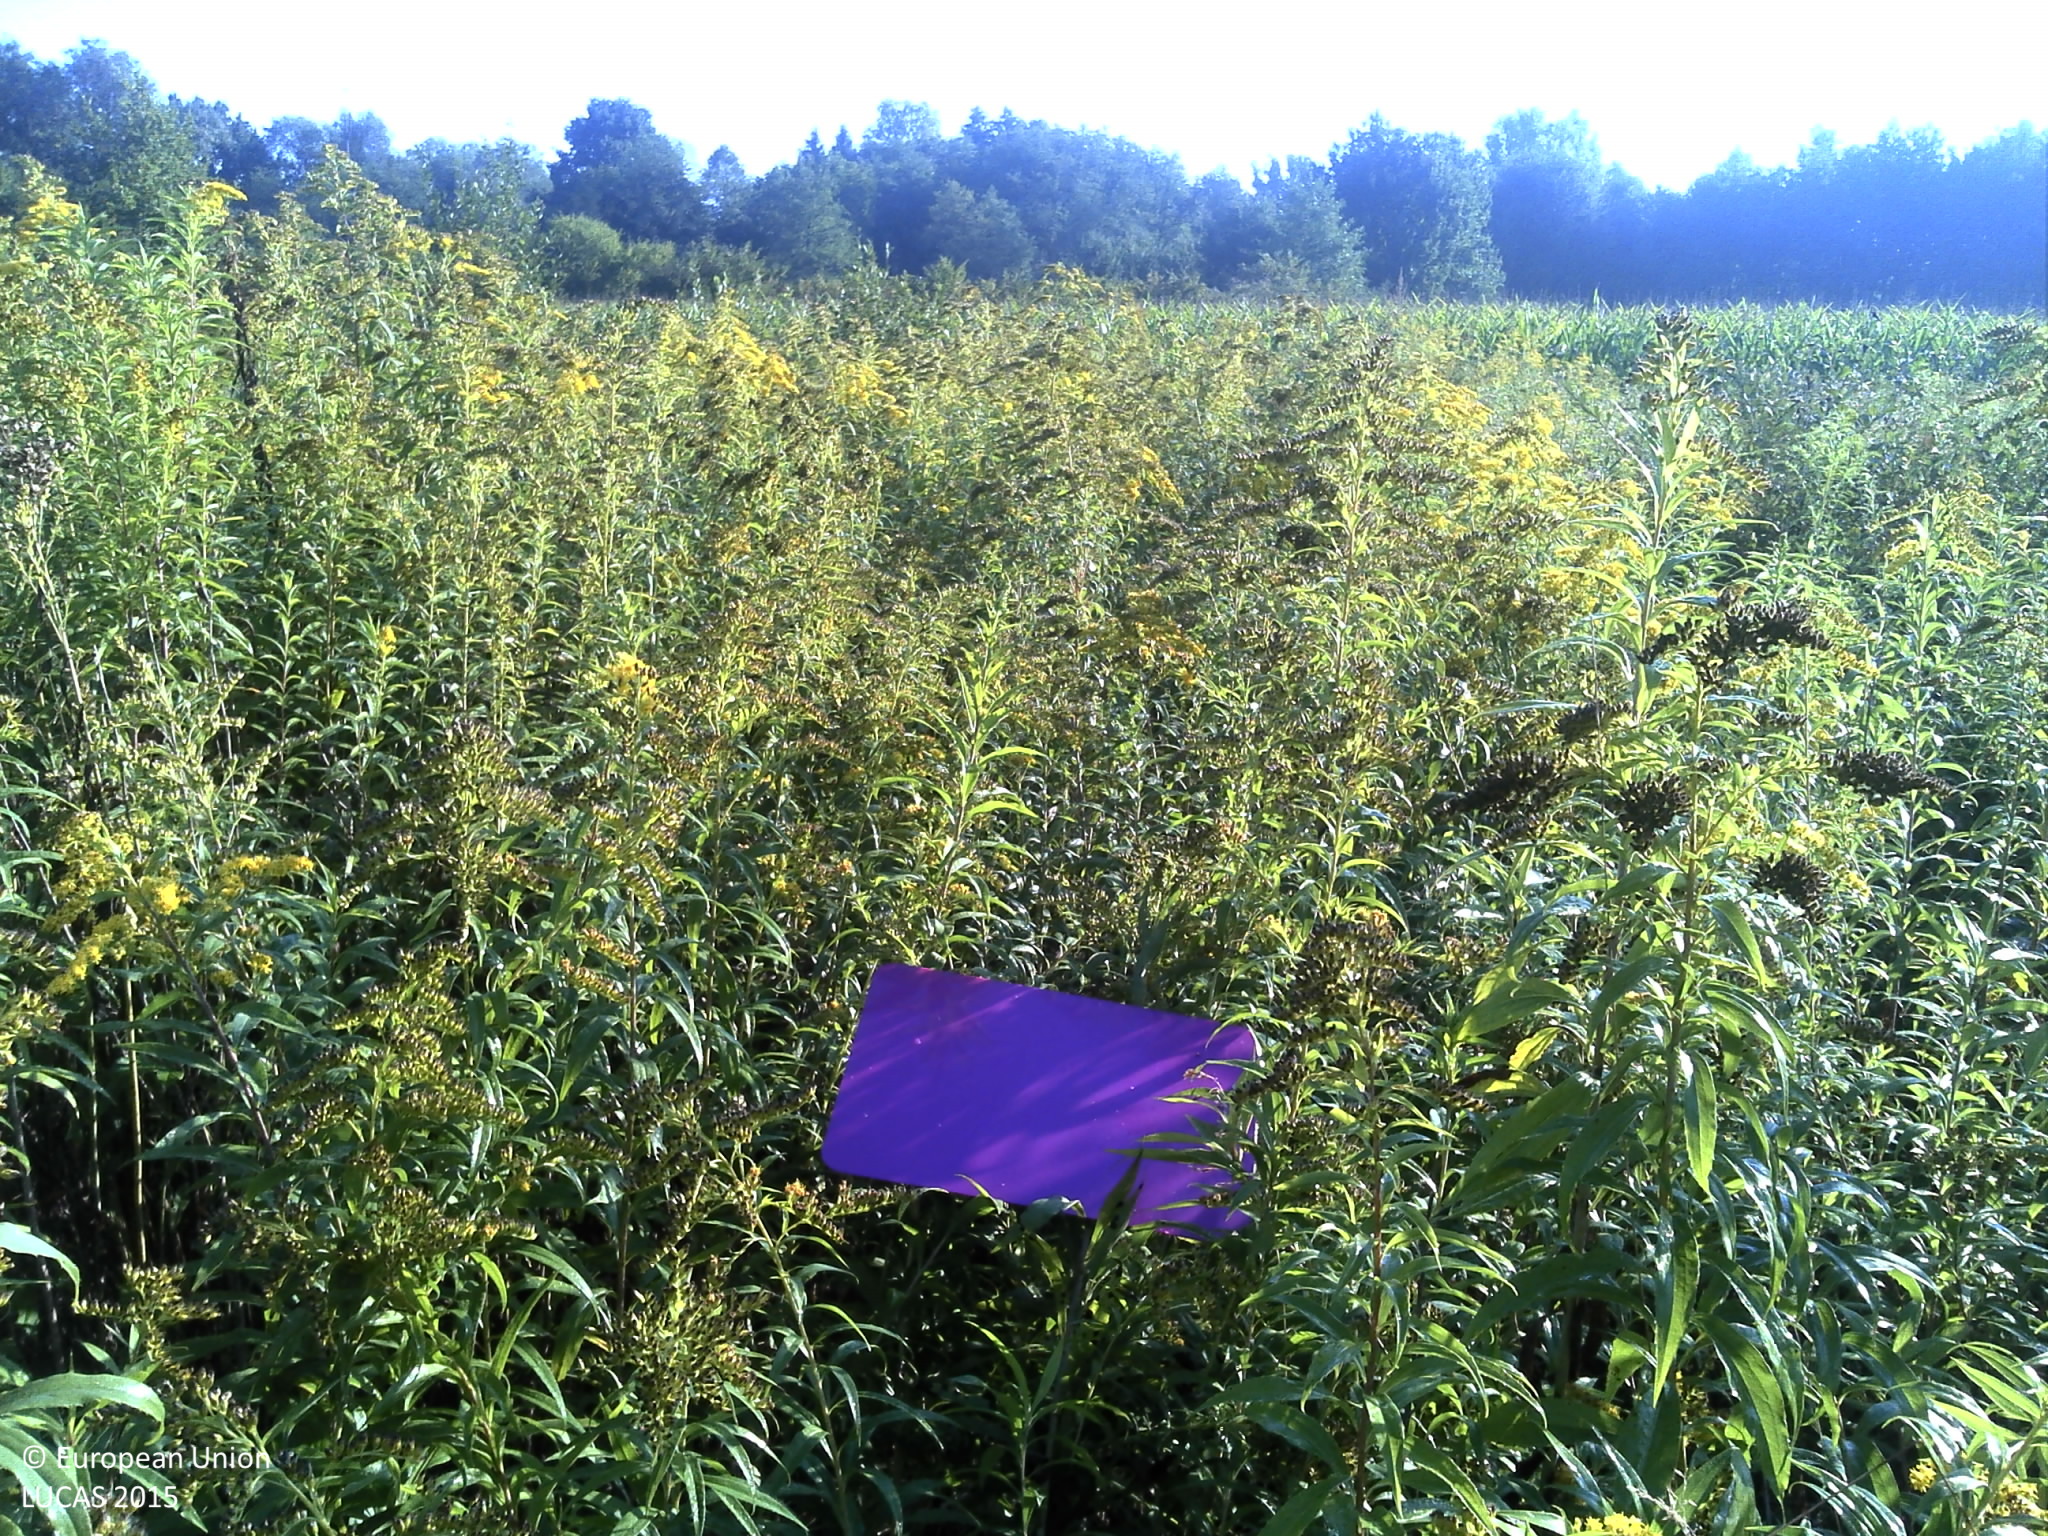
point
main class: Grassland
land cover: Spontaneously vegetated surfaces
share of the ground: > 75 %
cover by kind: herbaceous plants 100 %
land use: Fallow land
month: August
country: HR
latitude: 45.3275
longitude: 16.1082
